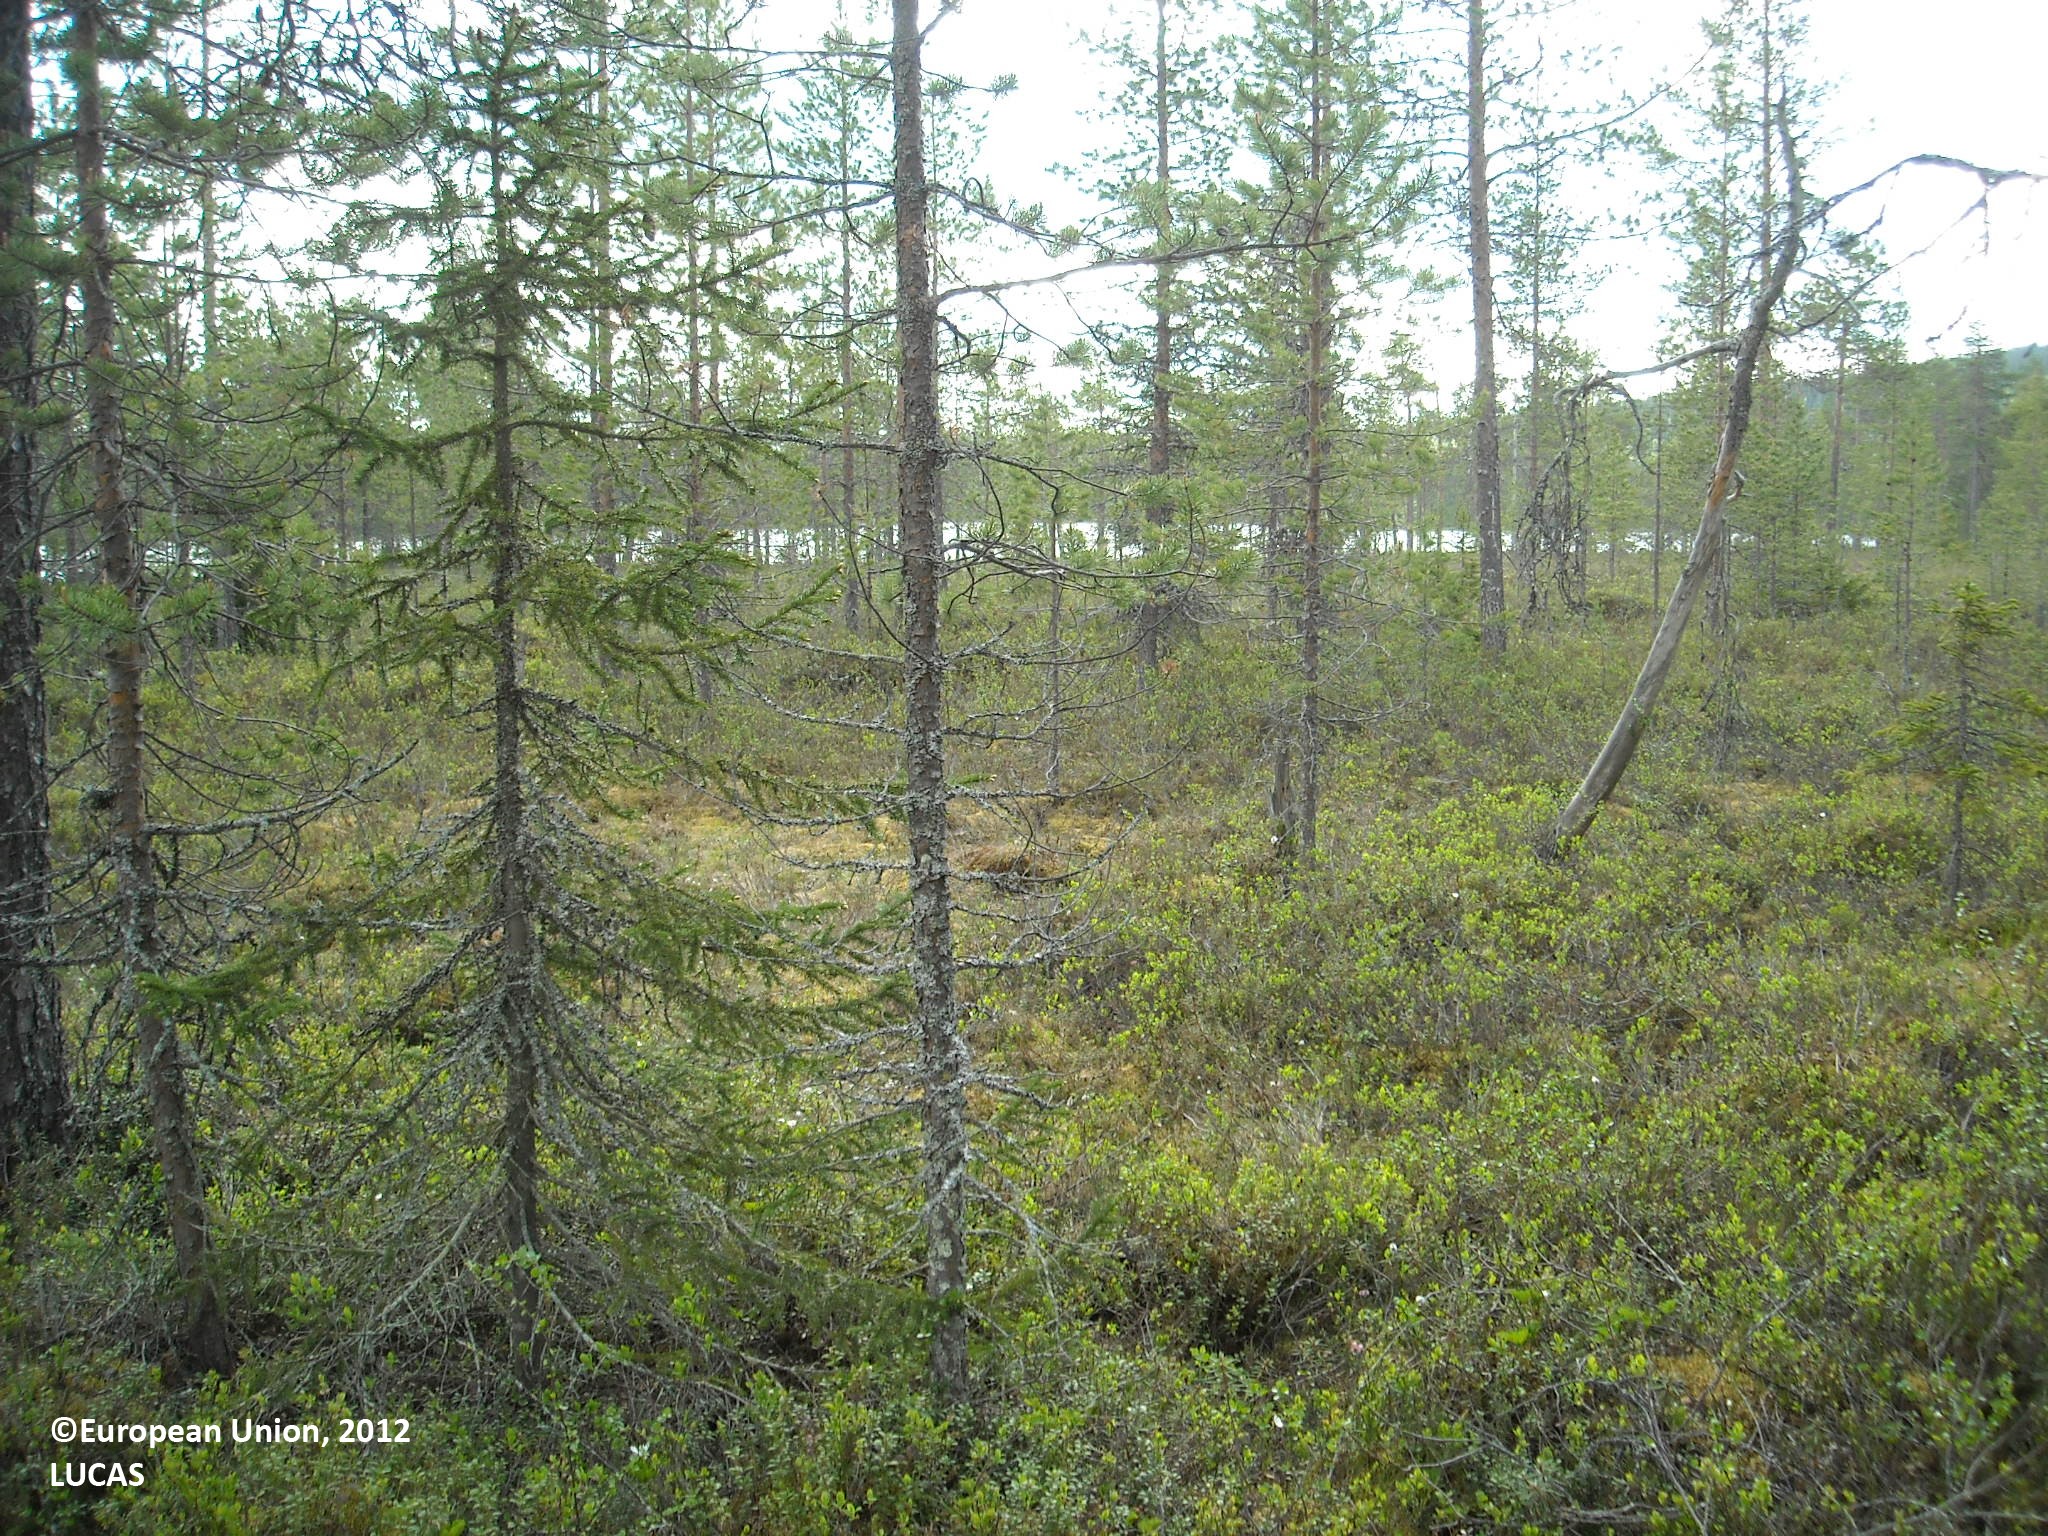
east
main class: Woodland
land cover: Pine dominated coniferous woodland
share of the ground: 25 - 50 %
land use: Forestry
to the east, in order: Pine dominated coniferous woodland; Ditches and canals; Pine dominated coniferous woodland; Inland water bodies
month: June
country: FI
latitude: 65.7250
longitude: 27.9947
